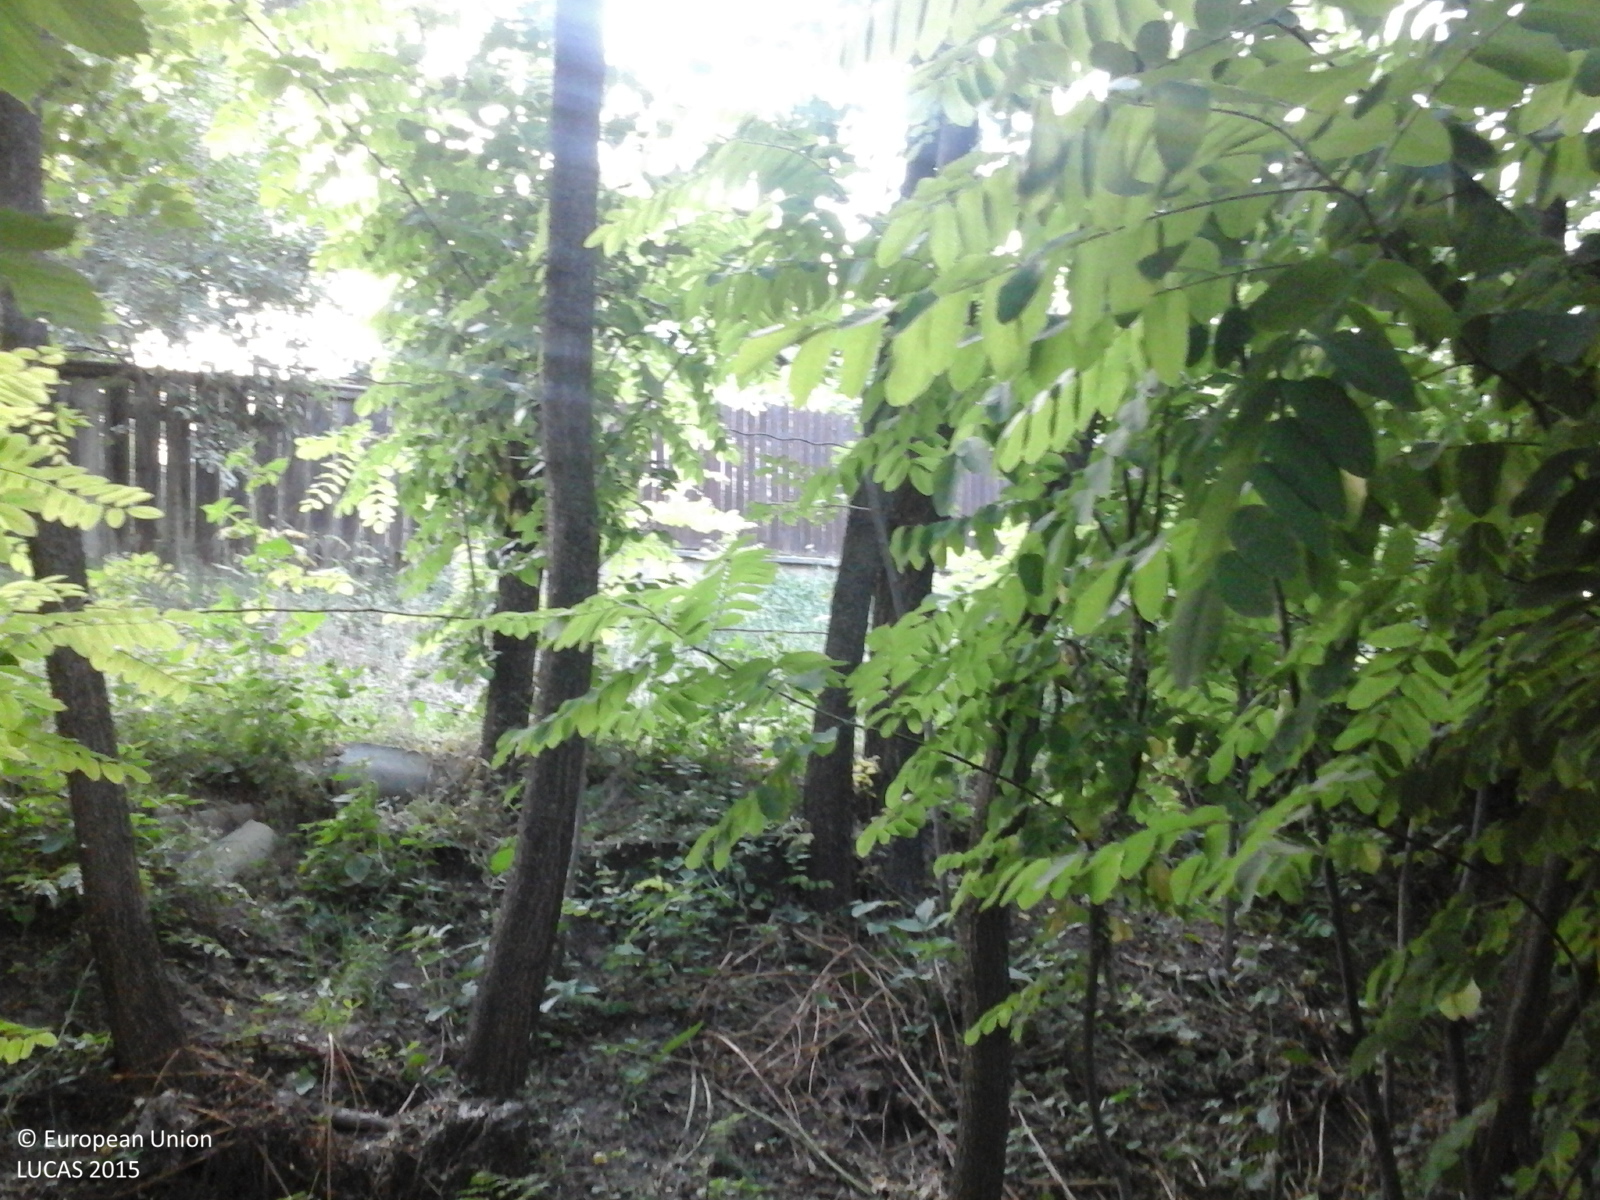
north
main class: Woodland
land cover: Broadleaved woodland
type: floodplain forest
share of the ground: > 75 %
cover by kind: broadleaved forest trees 100 %
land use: Semi-natural and natural areas not in use
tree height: > 5 m
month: June
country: RO
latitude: 47.5172
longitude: 26.5162
